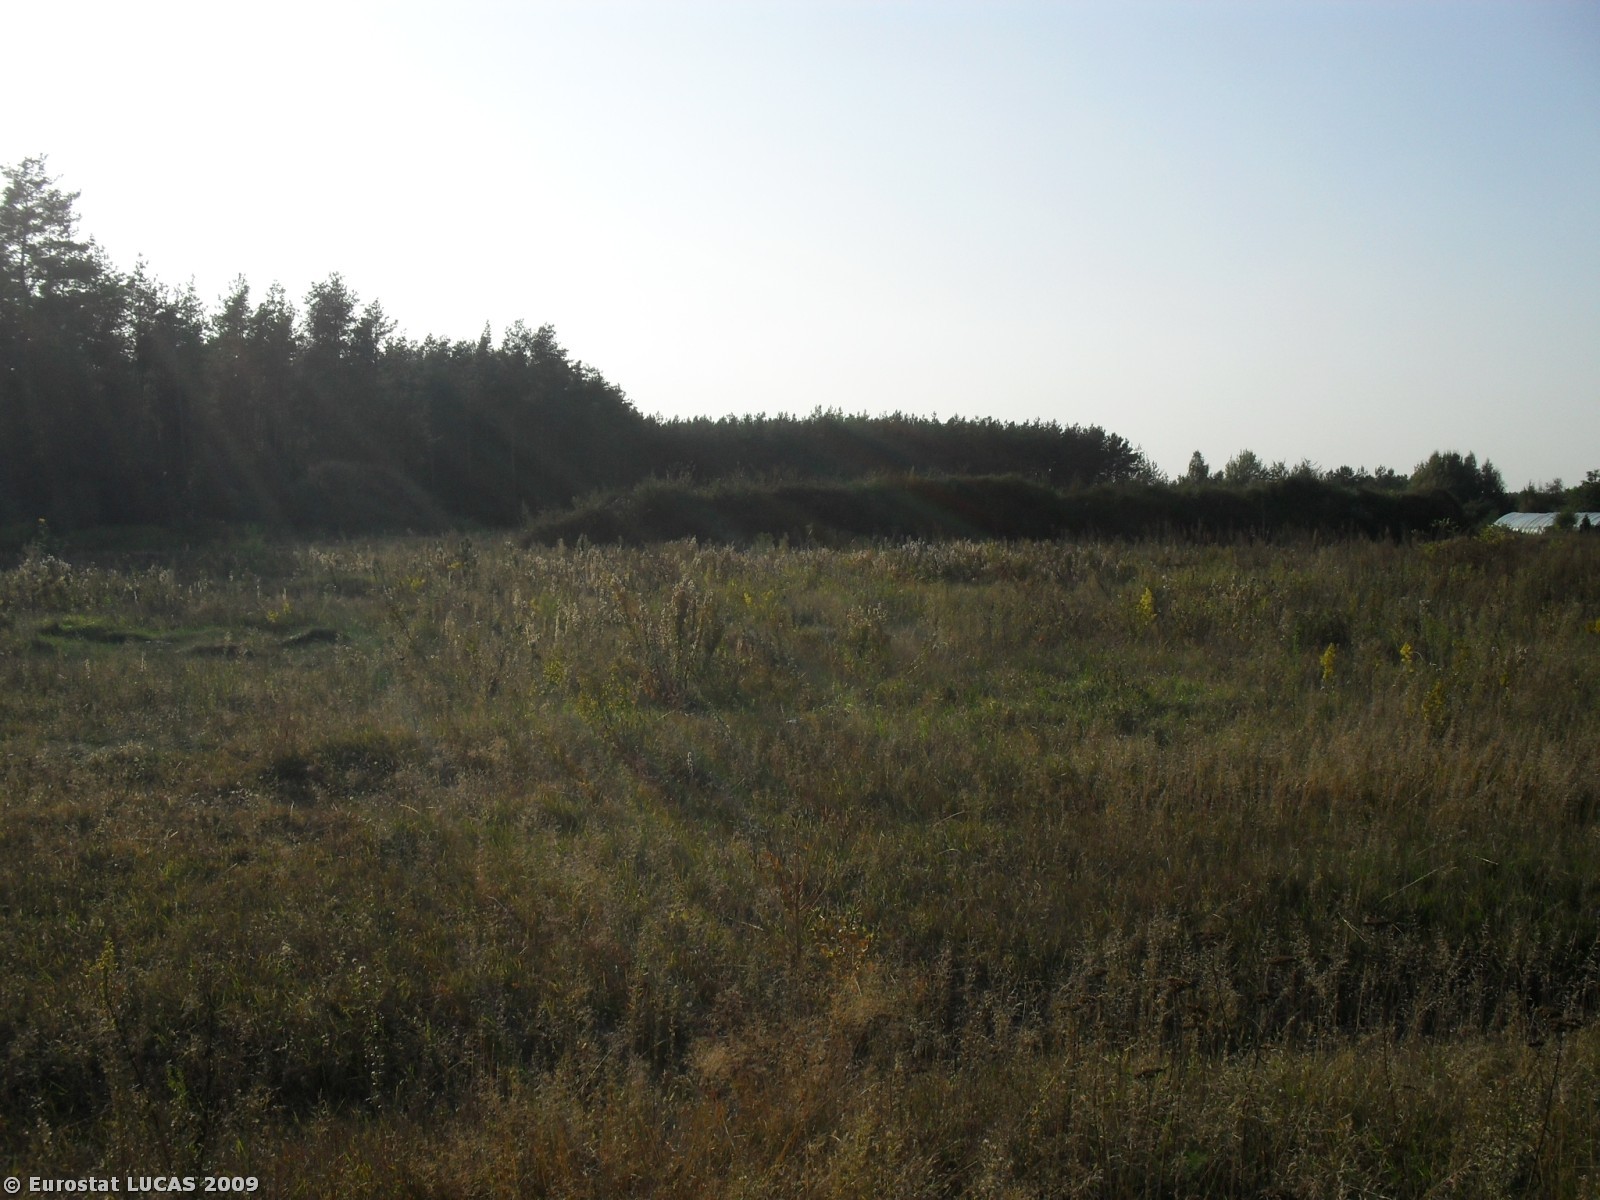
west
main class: Grassland
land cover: Grassland without tree/shrub cover
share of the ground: > 75 %
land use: Unused
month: September
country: PL
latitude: 51.9766
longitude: 20.7709
